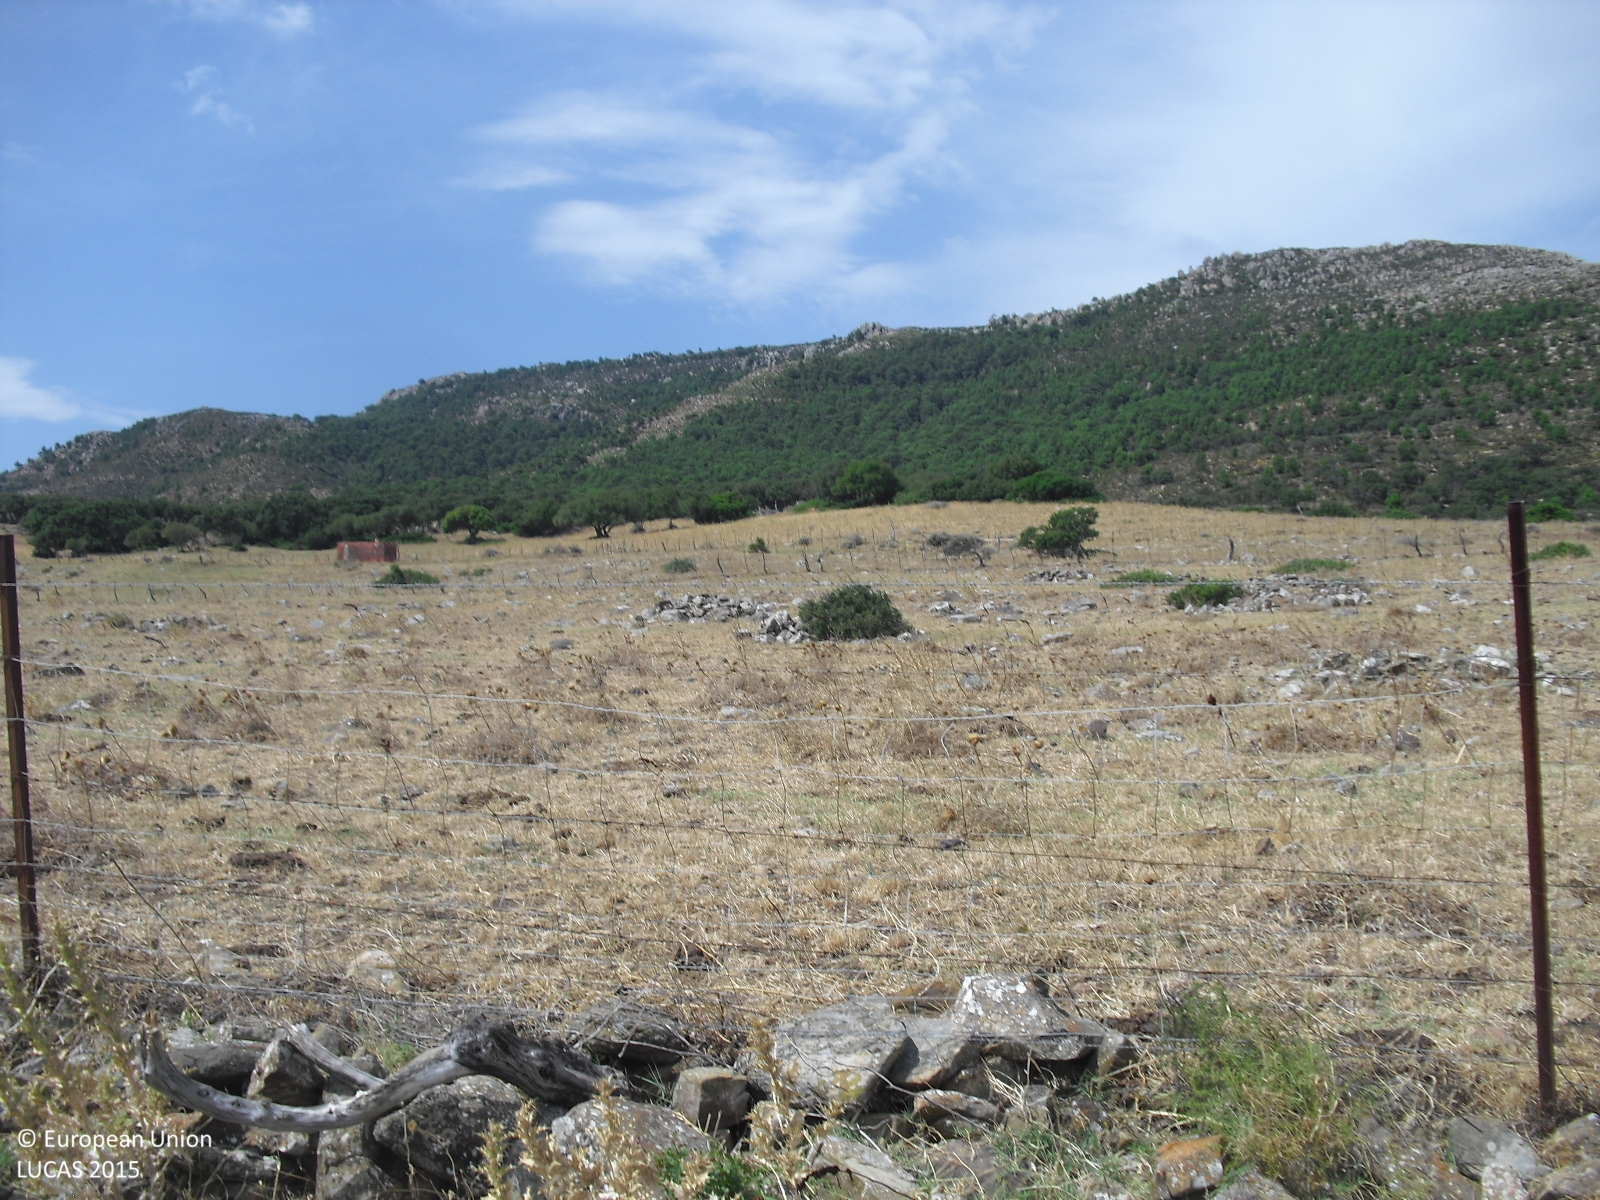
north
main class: Grassland
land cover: Grassland without tree/shrub cover
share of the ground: > 75 %
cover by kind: herbaceous plants 95 %, unconsolidated bare surface 5 %
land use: Agriculture (excluding fallow land and kitchen gardens)
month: July
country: ES
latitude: 36.1014
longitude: -5.5988
